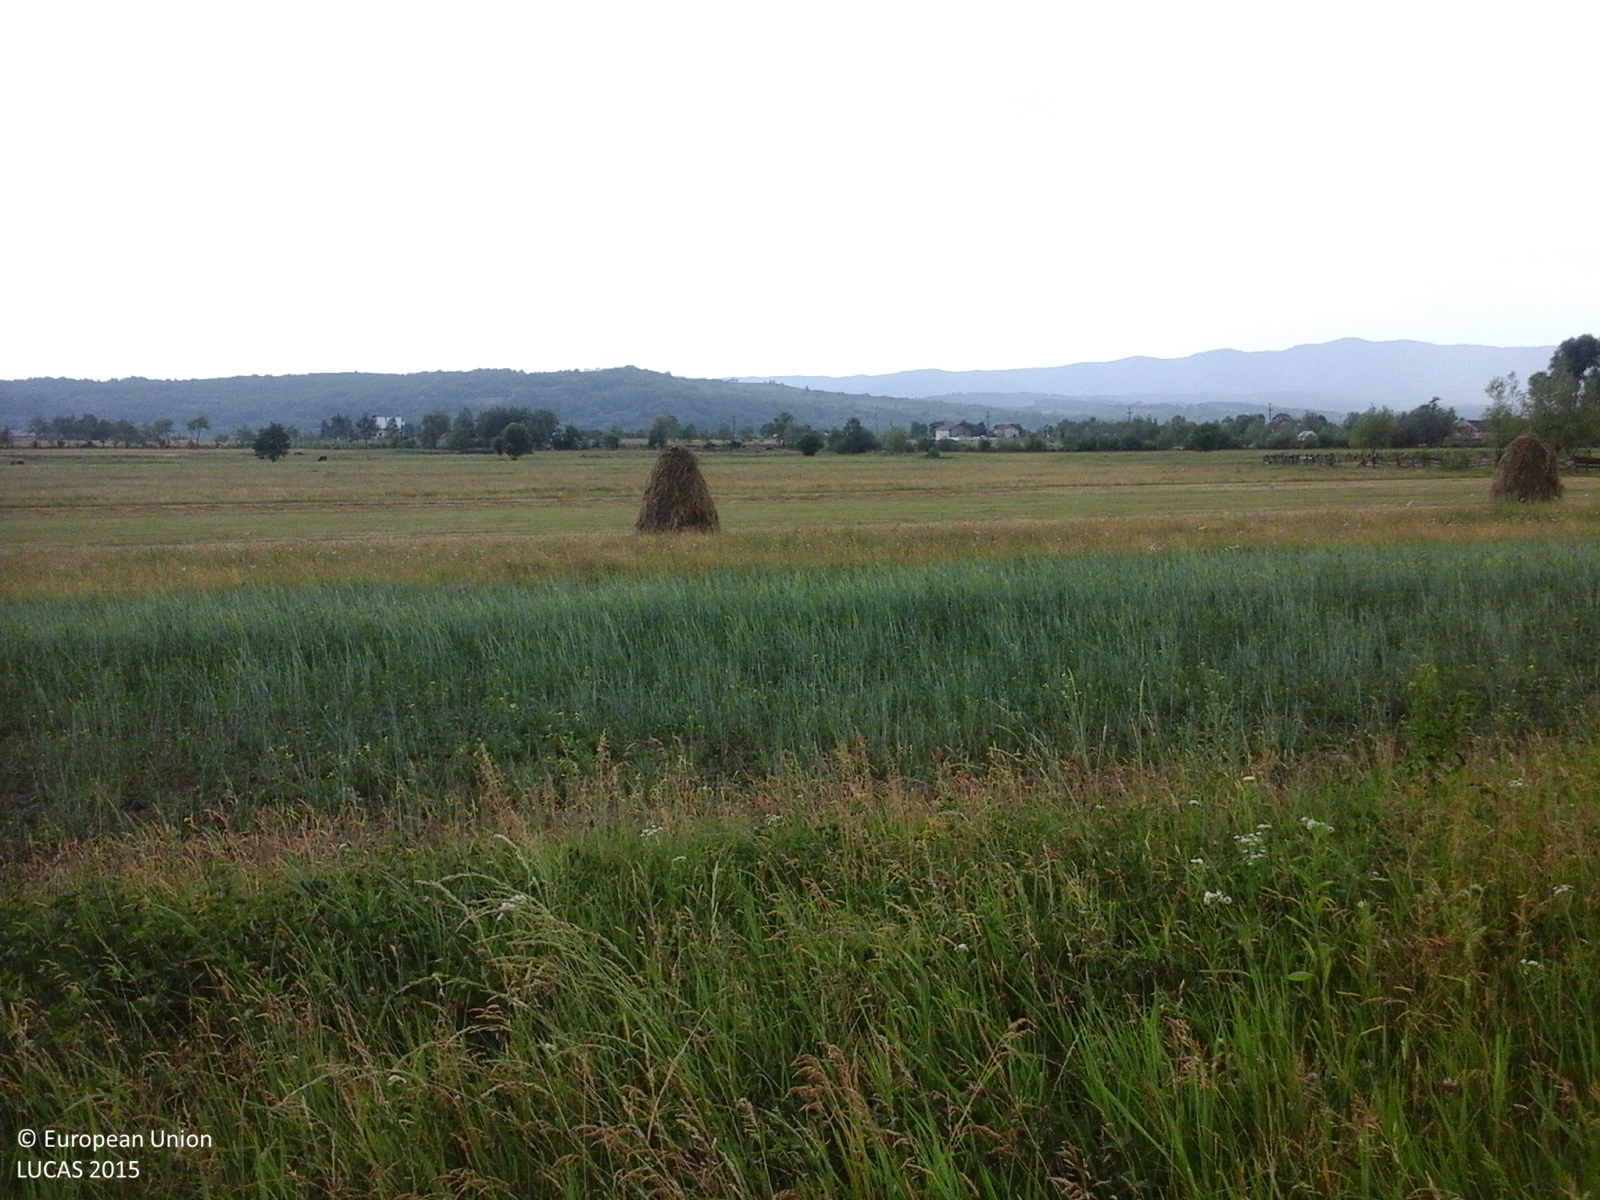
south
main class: Grassland
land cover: Grassland without tree/shrub cover
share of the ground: > 75 %
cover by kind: herbaceous plants 100 %
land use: Agriculture (excluding fallow land and kitchen gardens)
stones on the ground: < 10 %
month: June
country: RO
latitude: 47.3739
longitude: 26.2518
